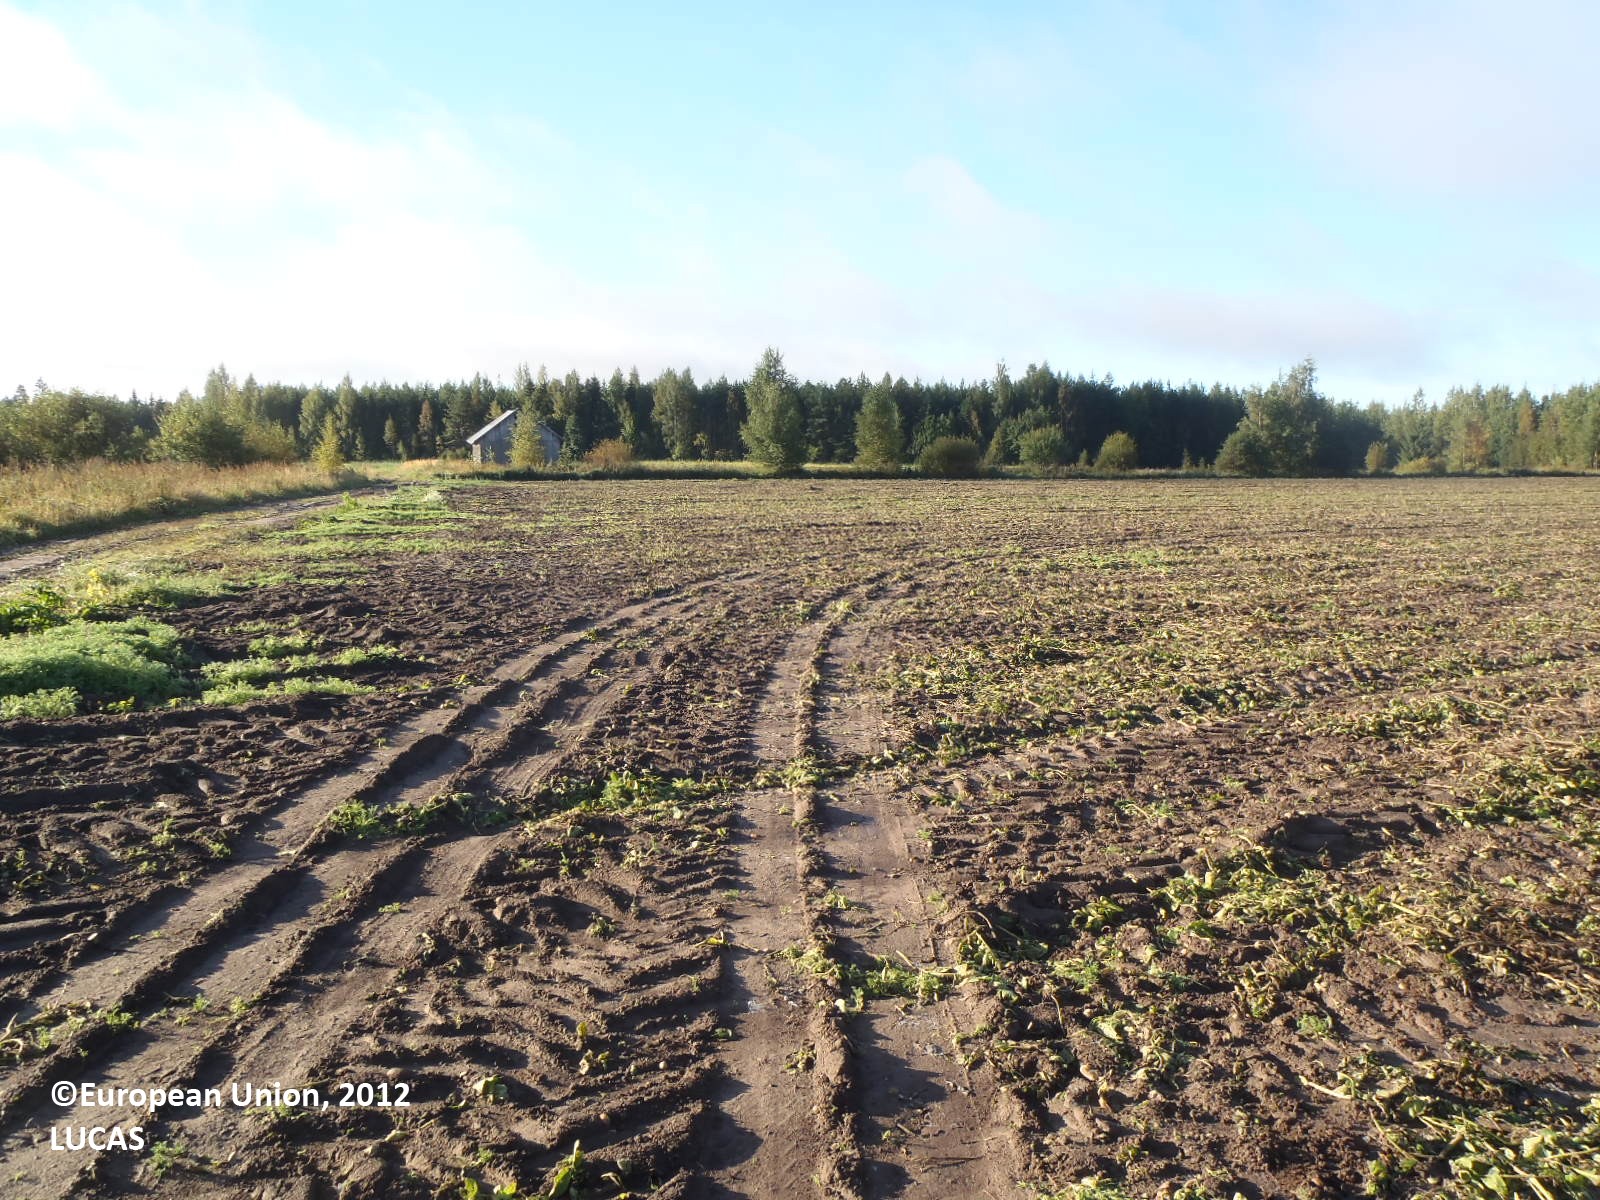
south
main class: Cropland
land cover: Potatoes
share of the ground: 50 - 75 %
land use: Agriculture (excluding fallow land and kitchen gardens)
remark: Harvested field
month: September
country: FI
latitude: 61.0537
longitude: 22.4197
